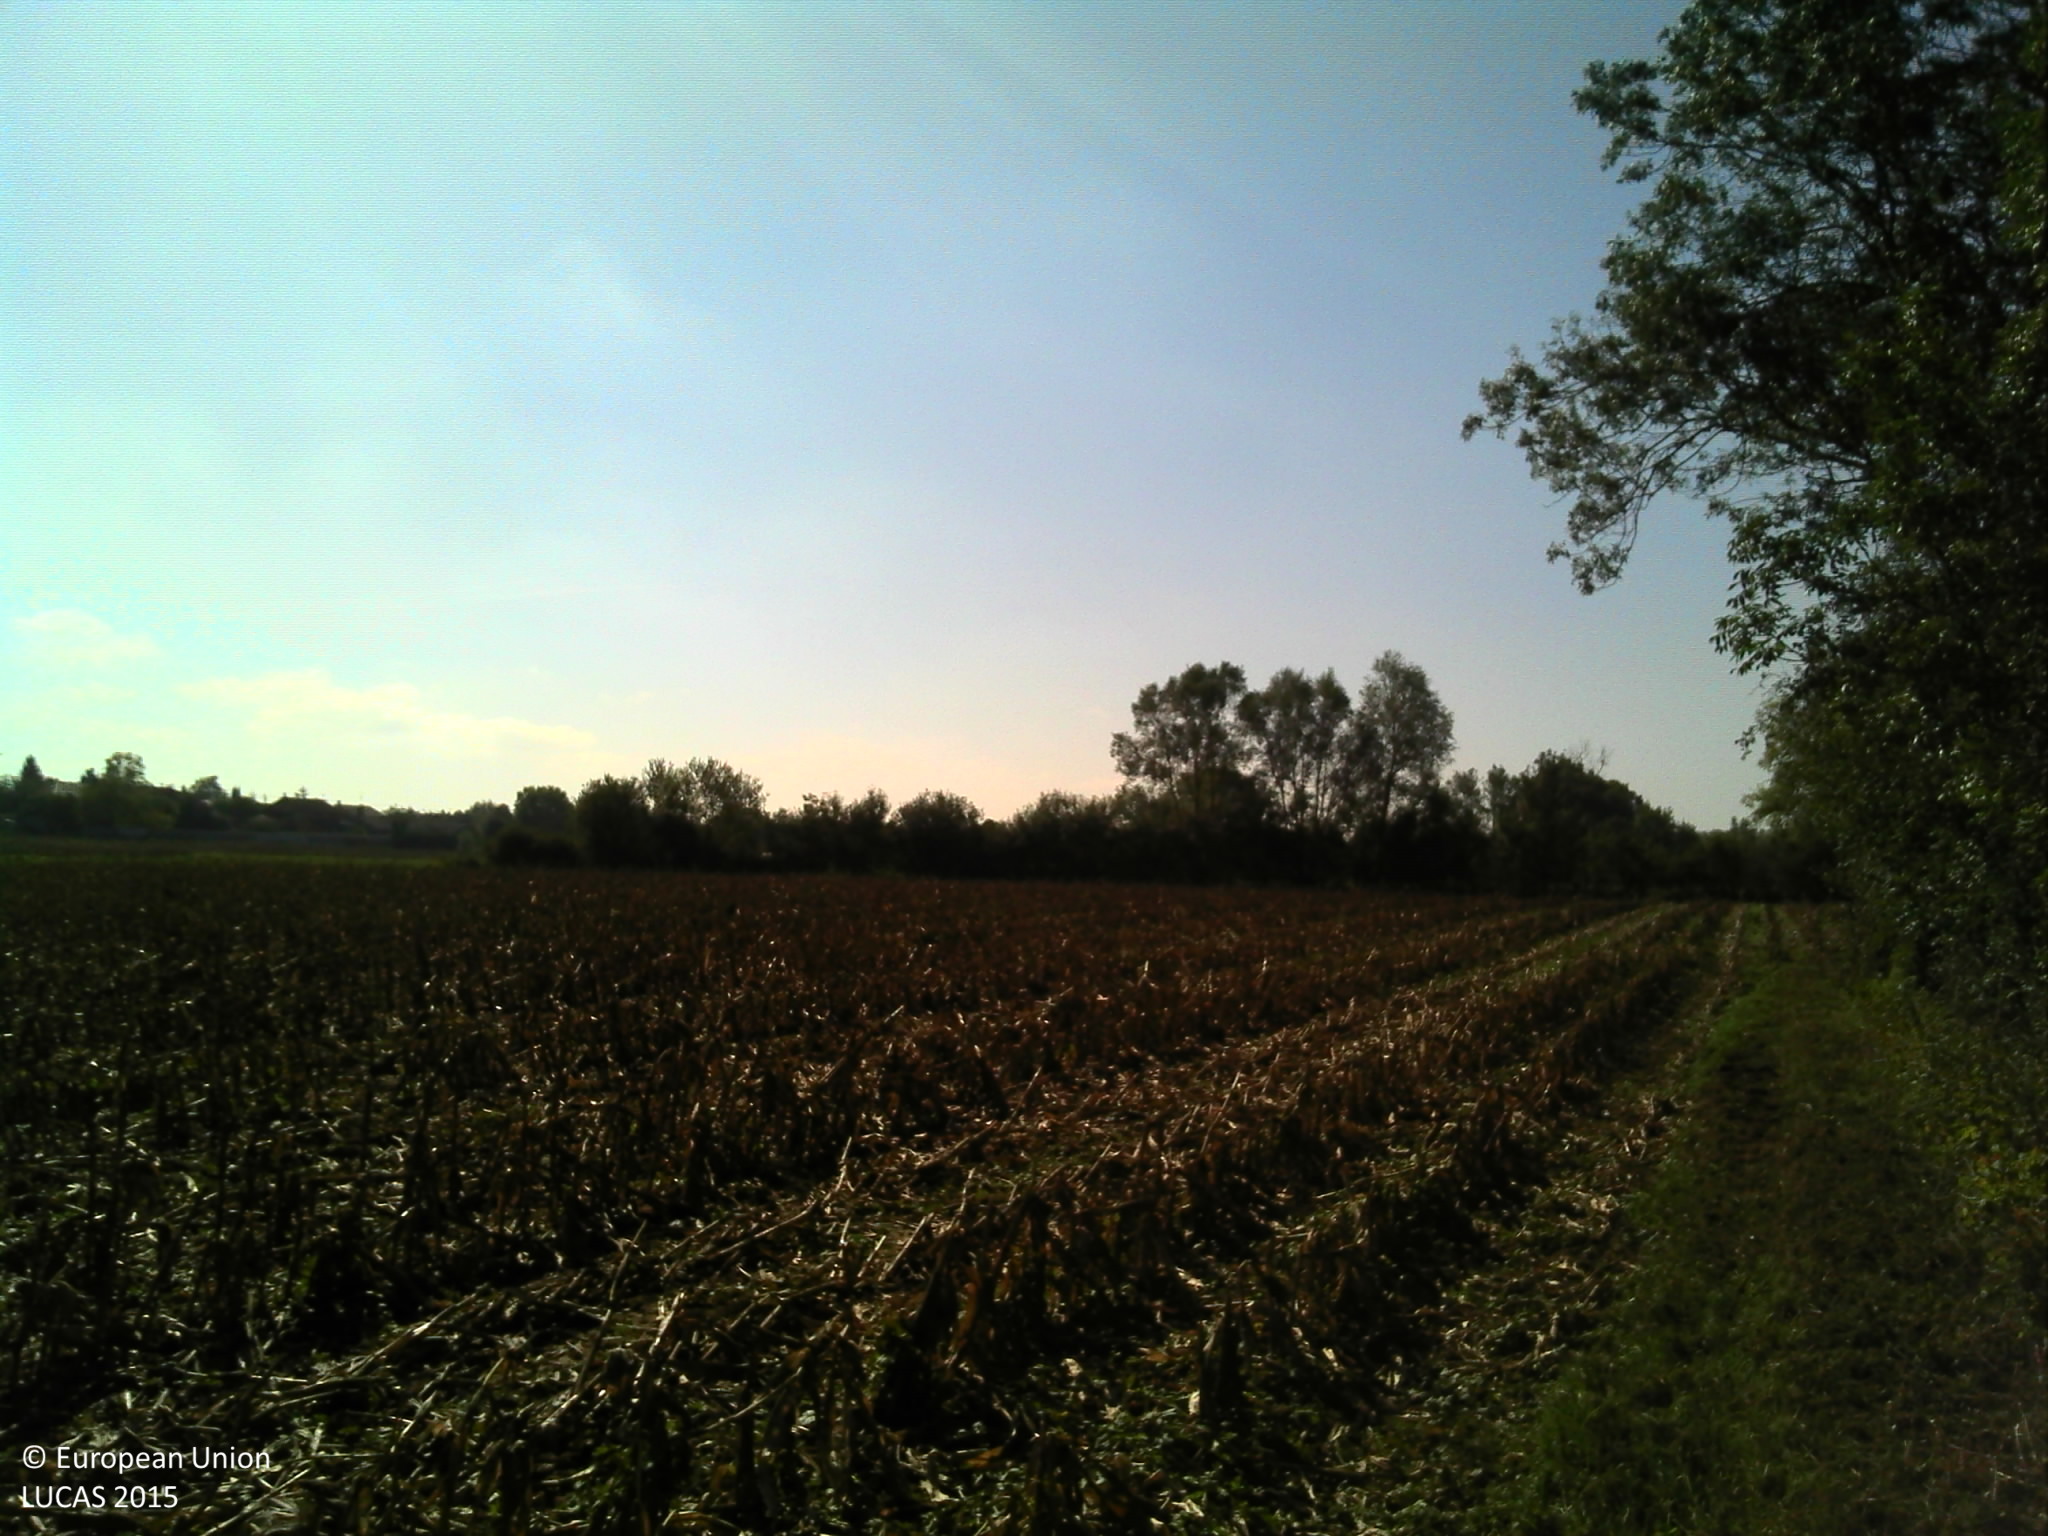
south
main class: Grassland
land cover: Grassland without tree/shrub cover
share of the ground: > 75 %
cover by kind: herbaceous plants 100 %
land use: Agriculture (excluding fallow land and kitchen gardens)
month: October
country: FR
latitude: 46.3185
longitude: 4.8724
